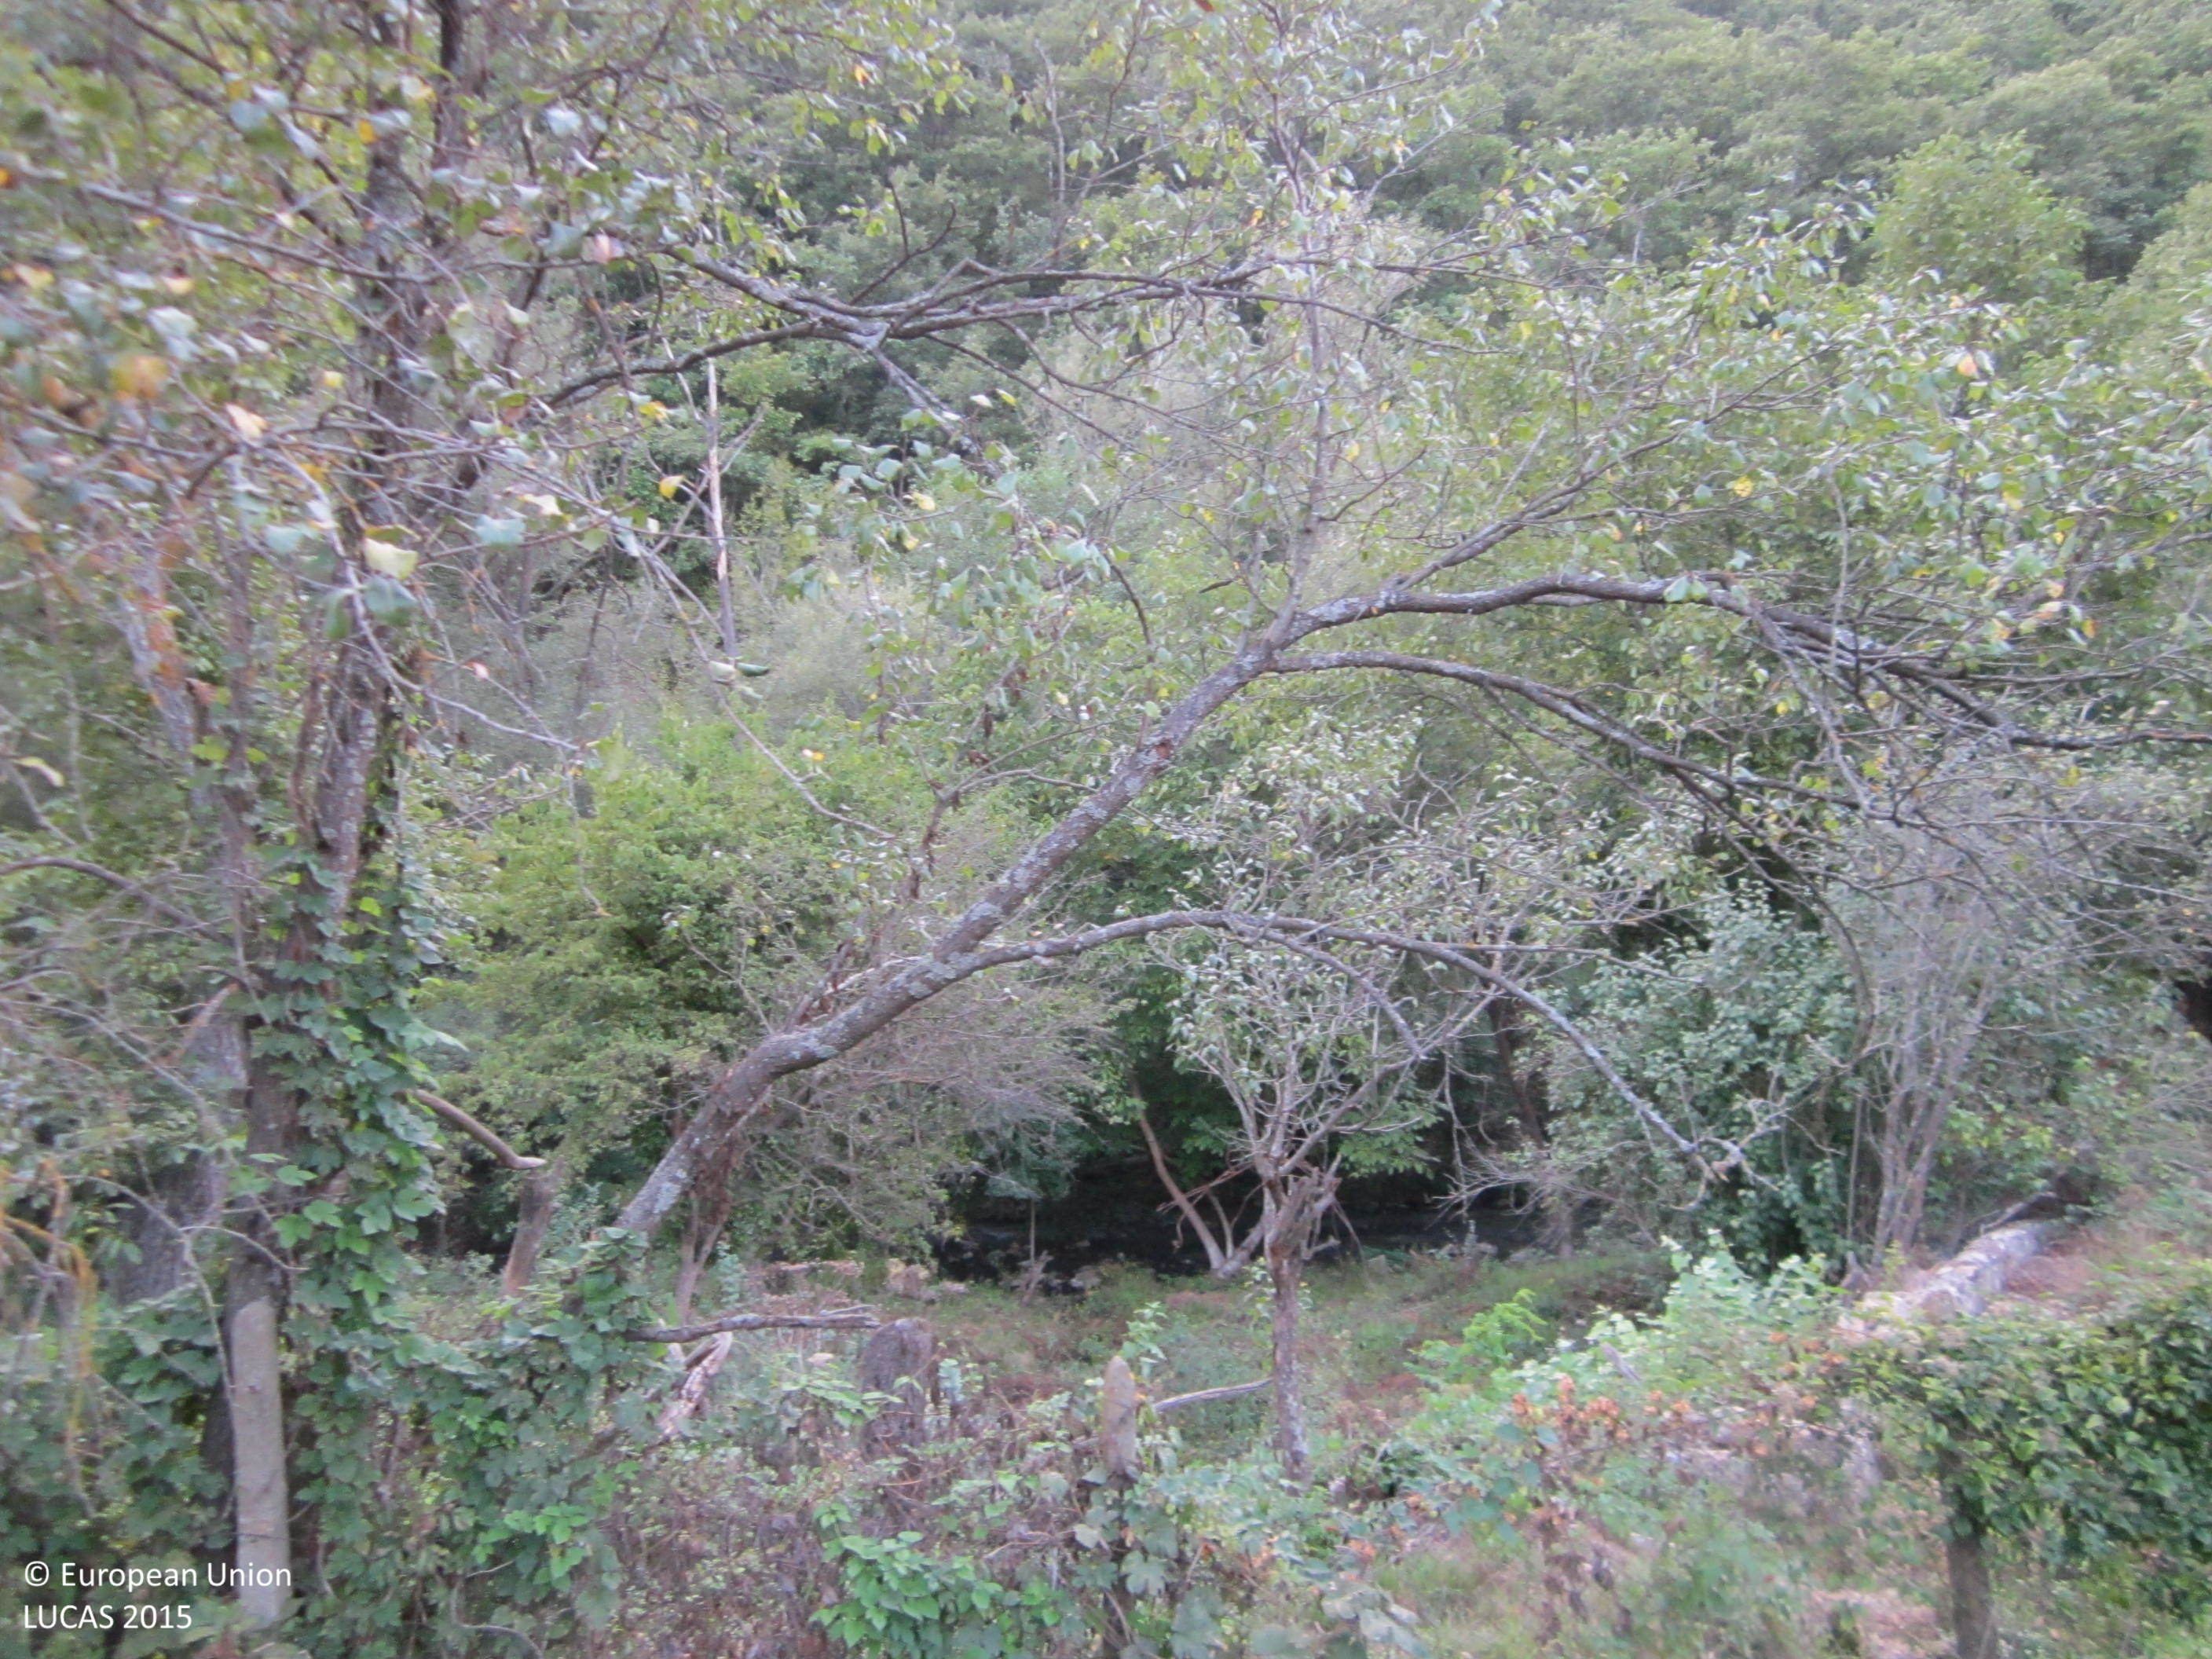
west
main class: Woodland
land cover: Broadleaved woodland
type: mesophytic deciduous forest
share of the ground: > 75 %
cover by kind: broadleaved forest trees 100 %
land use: Forestry
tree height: > 5 m
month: September
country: BG
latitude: 42.8486
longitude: 27.1843
